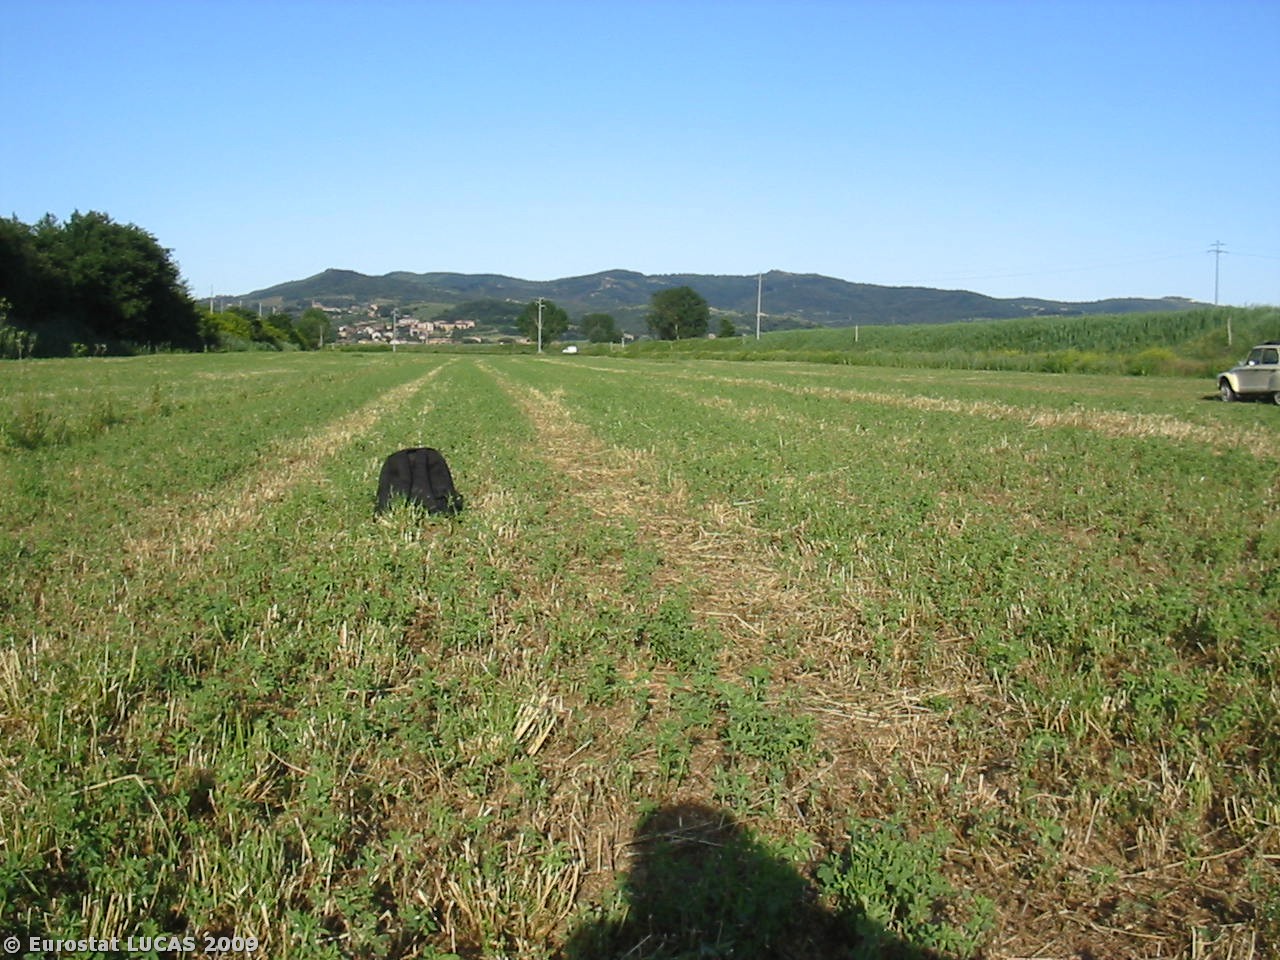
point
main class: Cropland
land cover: Lucerne
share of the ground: > 75 %
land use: Agriculture (excluding fallow land and kitchen gardens)
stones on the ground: < 10 %
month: May
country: IT
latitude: 43.0137
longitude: 11.9939
